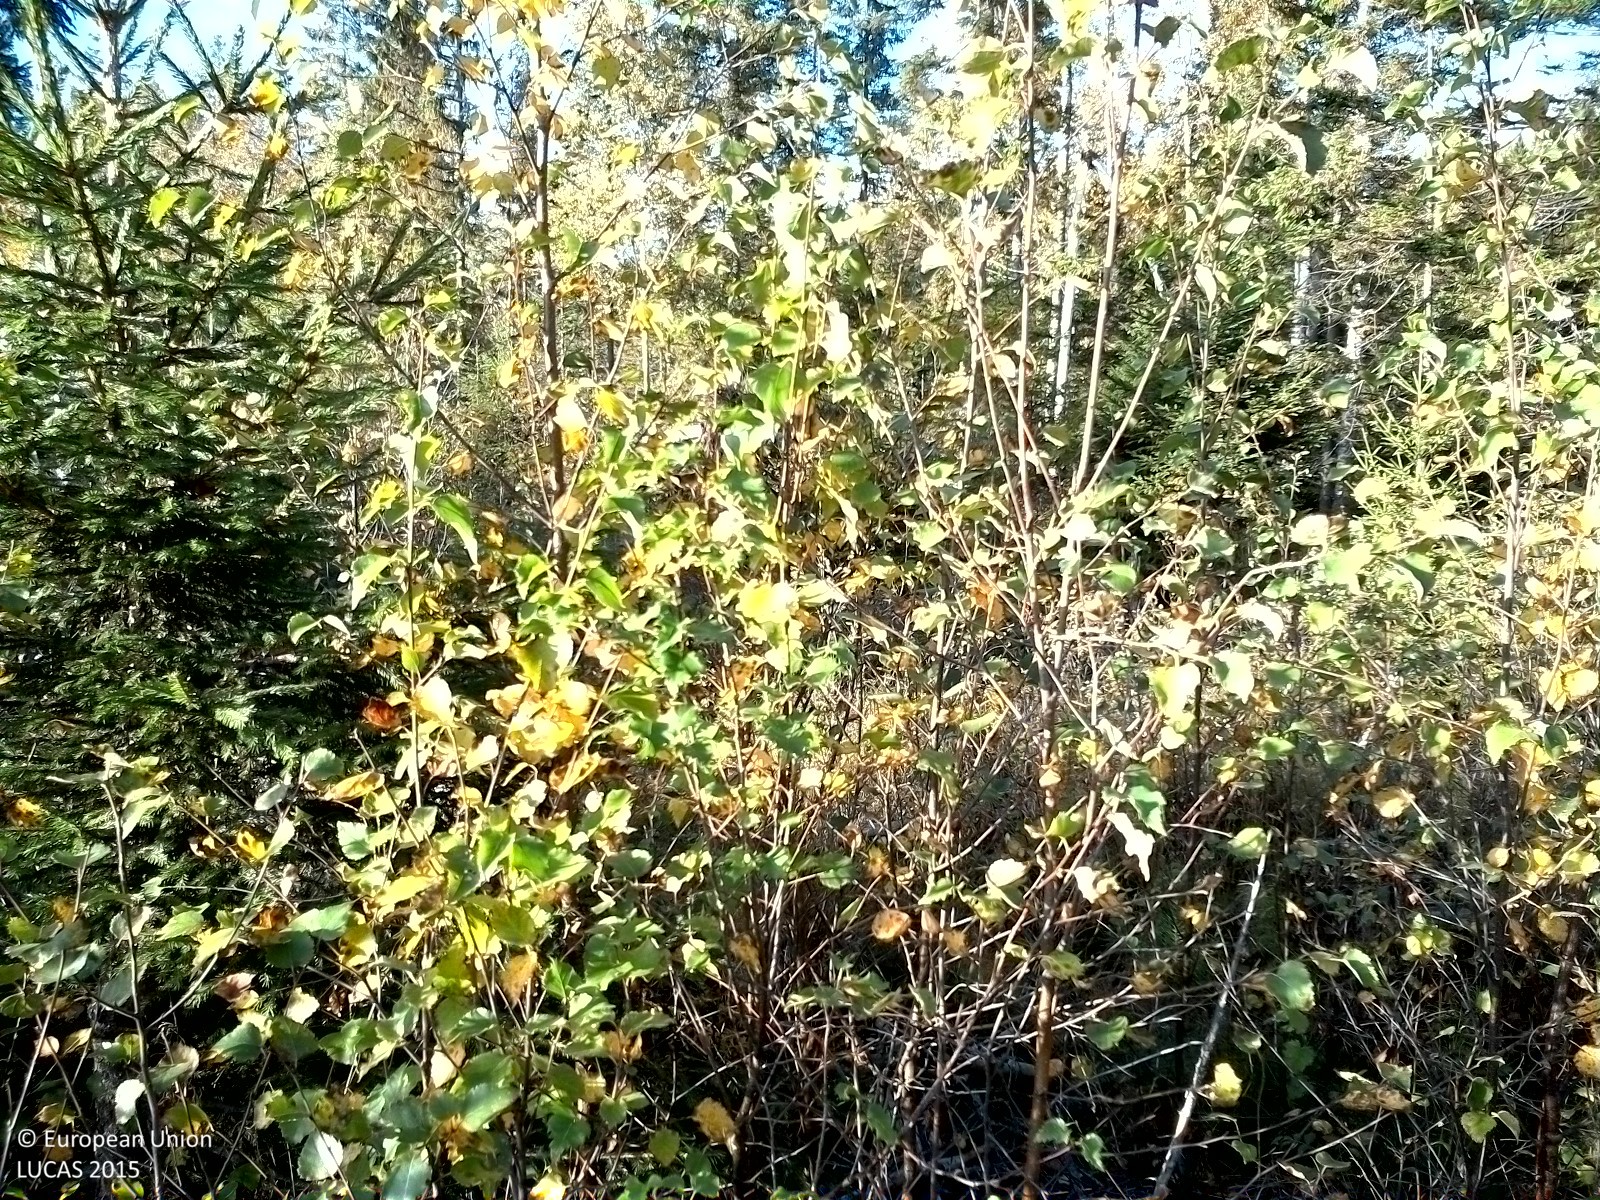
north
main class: Woodland
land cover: Spruce dominated mixed woodland
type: boreal forest
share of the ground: > 75 %
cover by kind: broadleaved forest trees 60 %, coniferous forest trees 20 %, shrubs 20 %
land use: Forestry
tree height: < 5 m
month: September
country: SE
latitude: 62.0958
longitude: 16.8194
